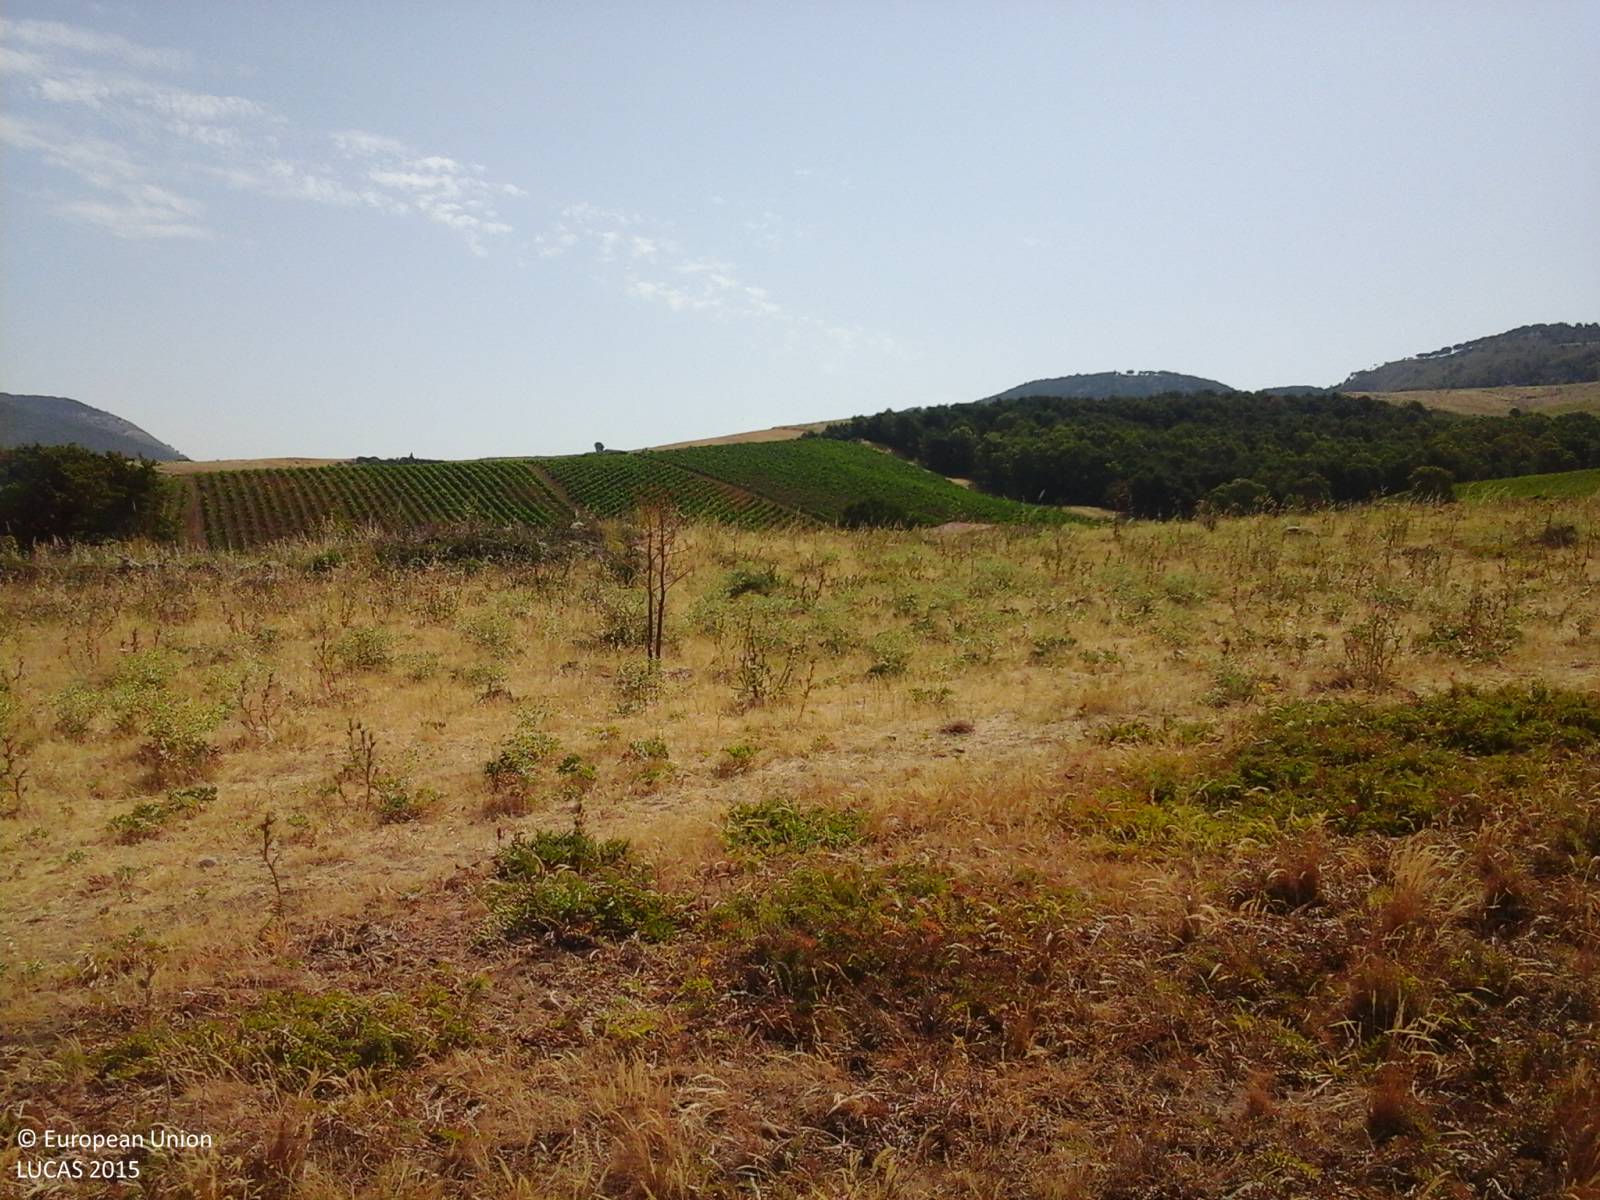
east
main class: Grassland
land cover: Grassland without tree/shrub cover
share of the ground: > 75 %
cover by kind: herbaceous plants 100 %
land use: Agriculture (excluding fallow land and kitchen gardens)
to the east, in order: Grassland without tree/shrub cover; Shrubland without tree cover; Ditches and canals; Durum wheat
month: June
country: IT
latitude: 37.8708
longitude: 12.7648
